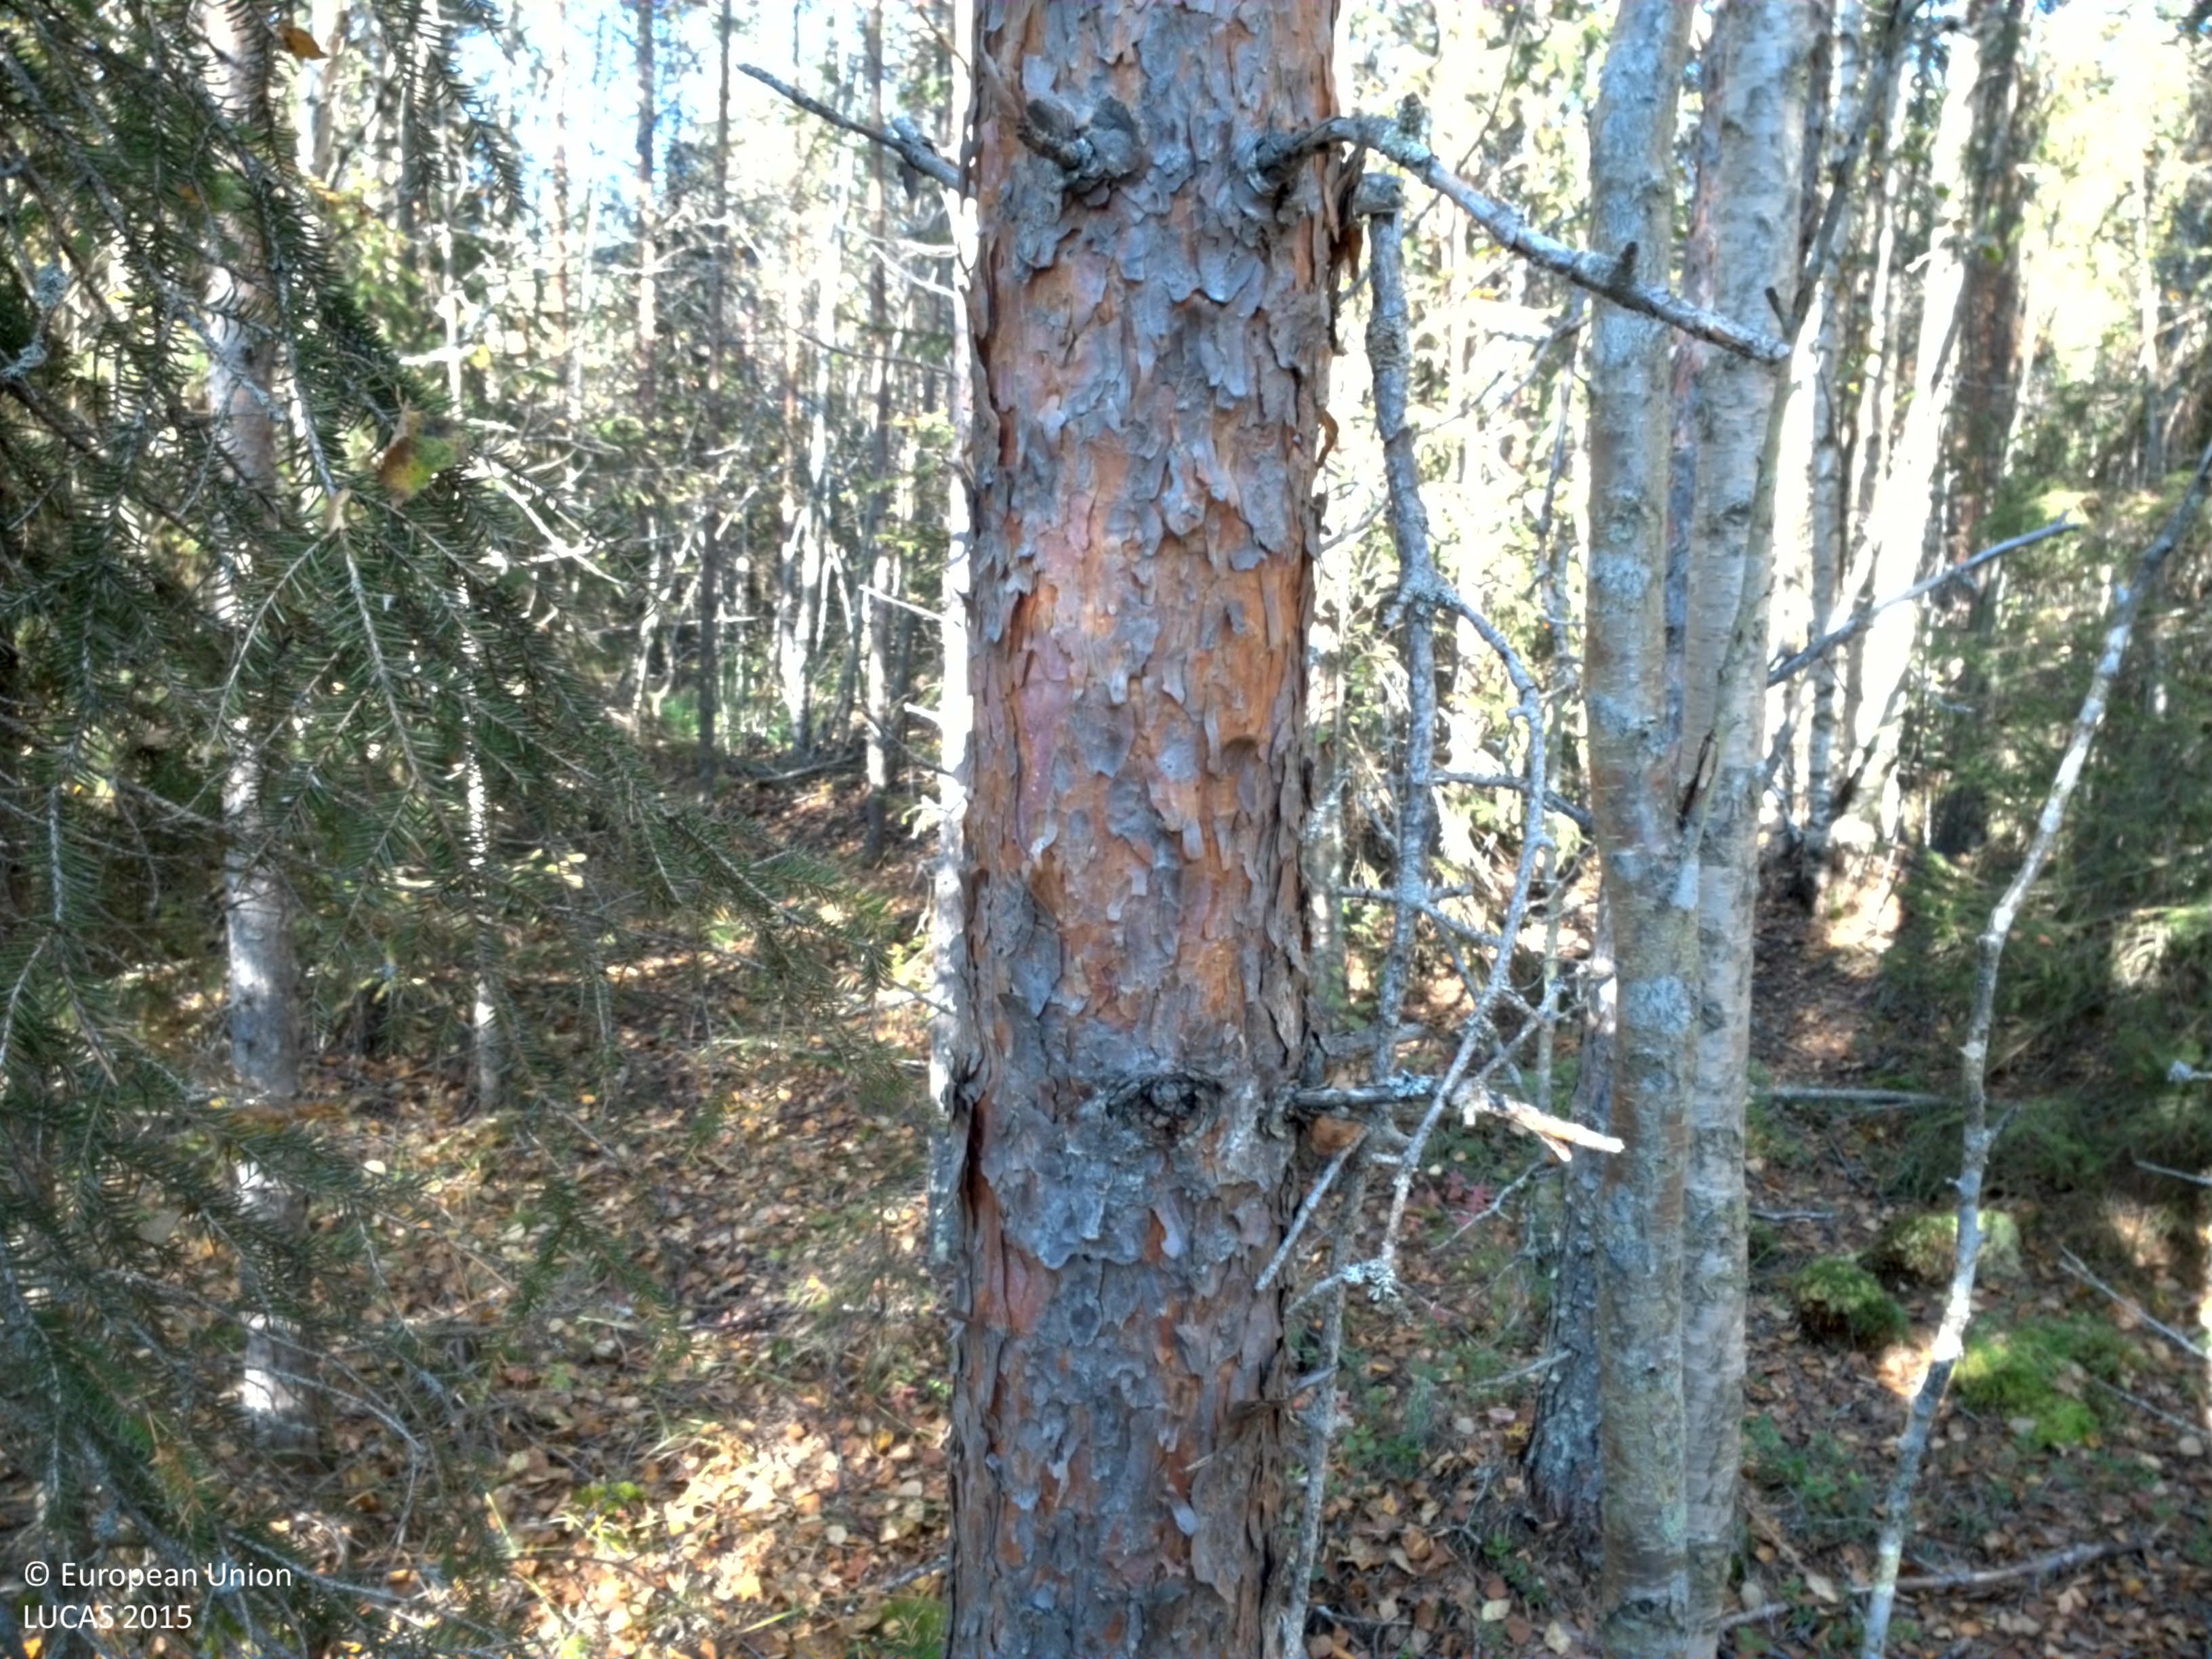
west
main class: Woodland
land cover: Pine dominated mixed woodland
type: boreal forest
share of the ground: 50 - 75 %
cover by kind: coniferous forest trees 35 %, broadleaved forest trees 30 %, shrubs 20 %, unconsolidated bare surface 10 %, lichens and mosses 5 %
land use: Forestry
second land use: Amenities, museums, leisure
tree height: < 5 m
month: September
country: SE
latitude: 65.5640
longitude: 22.3523
